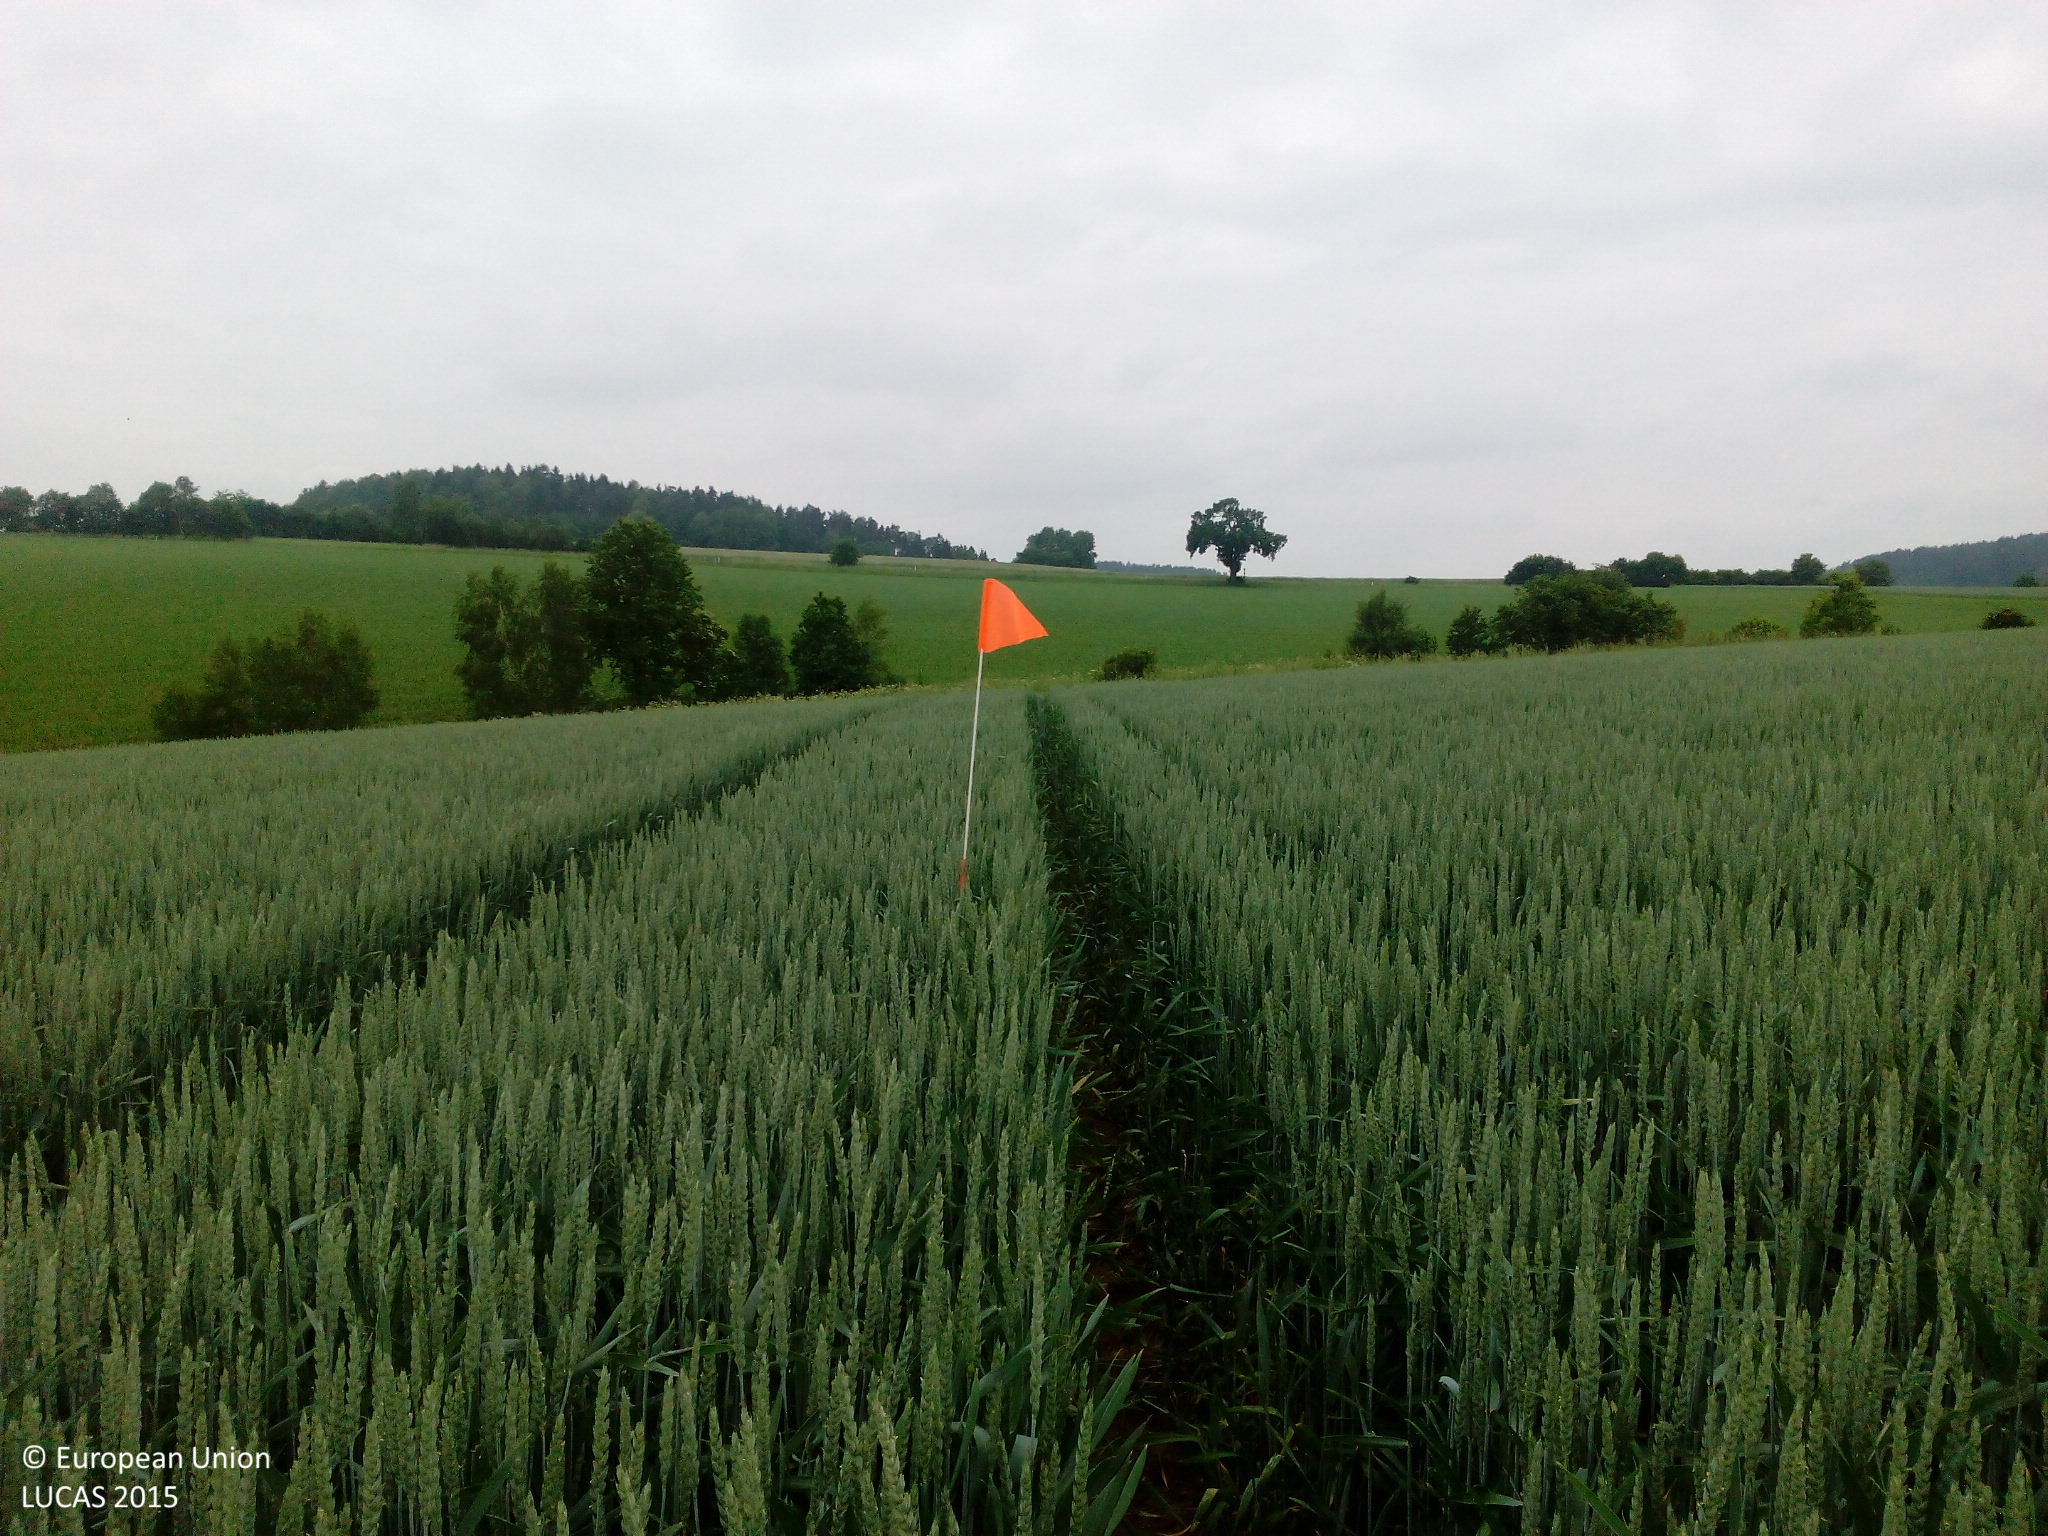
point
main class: Cropland
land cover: Common wheat
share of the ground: > 75 %
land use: Agriculture (excluding fallow land and kitchen gardens)
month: June
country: DE
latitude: 49.4582
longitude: 12.3587
